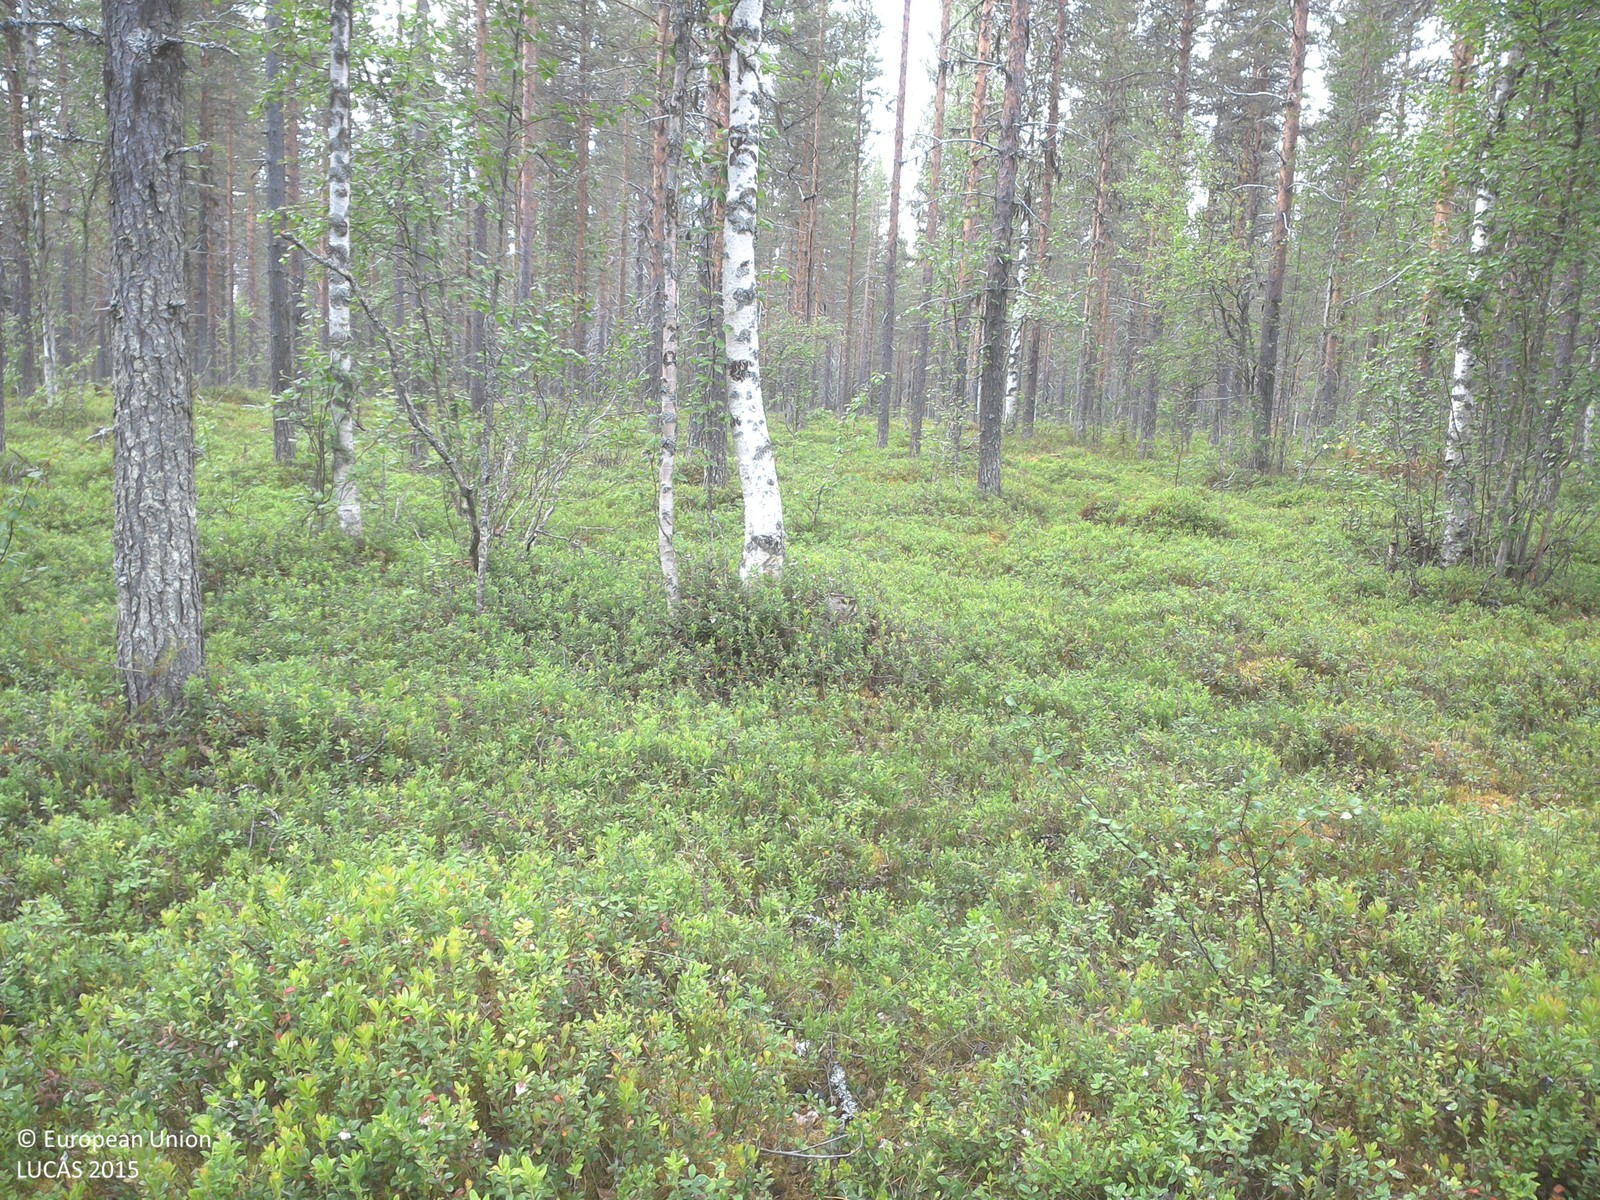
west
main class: Woodland
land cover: Pine dominated mixed woodland
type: boreal forest
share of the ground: 25 - 50 %
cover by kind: shrubs 55 %, coniferous forest trees 25 %, broadleaved forest trees 15 %, lichens and mosses 5 %
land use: Forestry
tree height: > 5 m
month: July
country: SE
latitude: 67.5909
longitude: 23.5313
